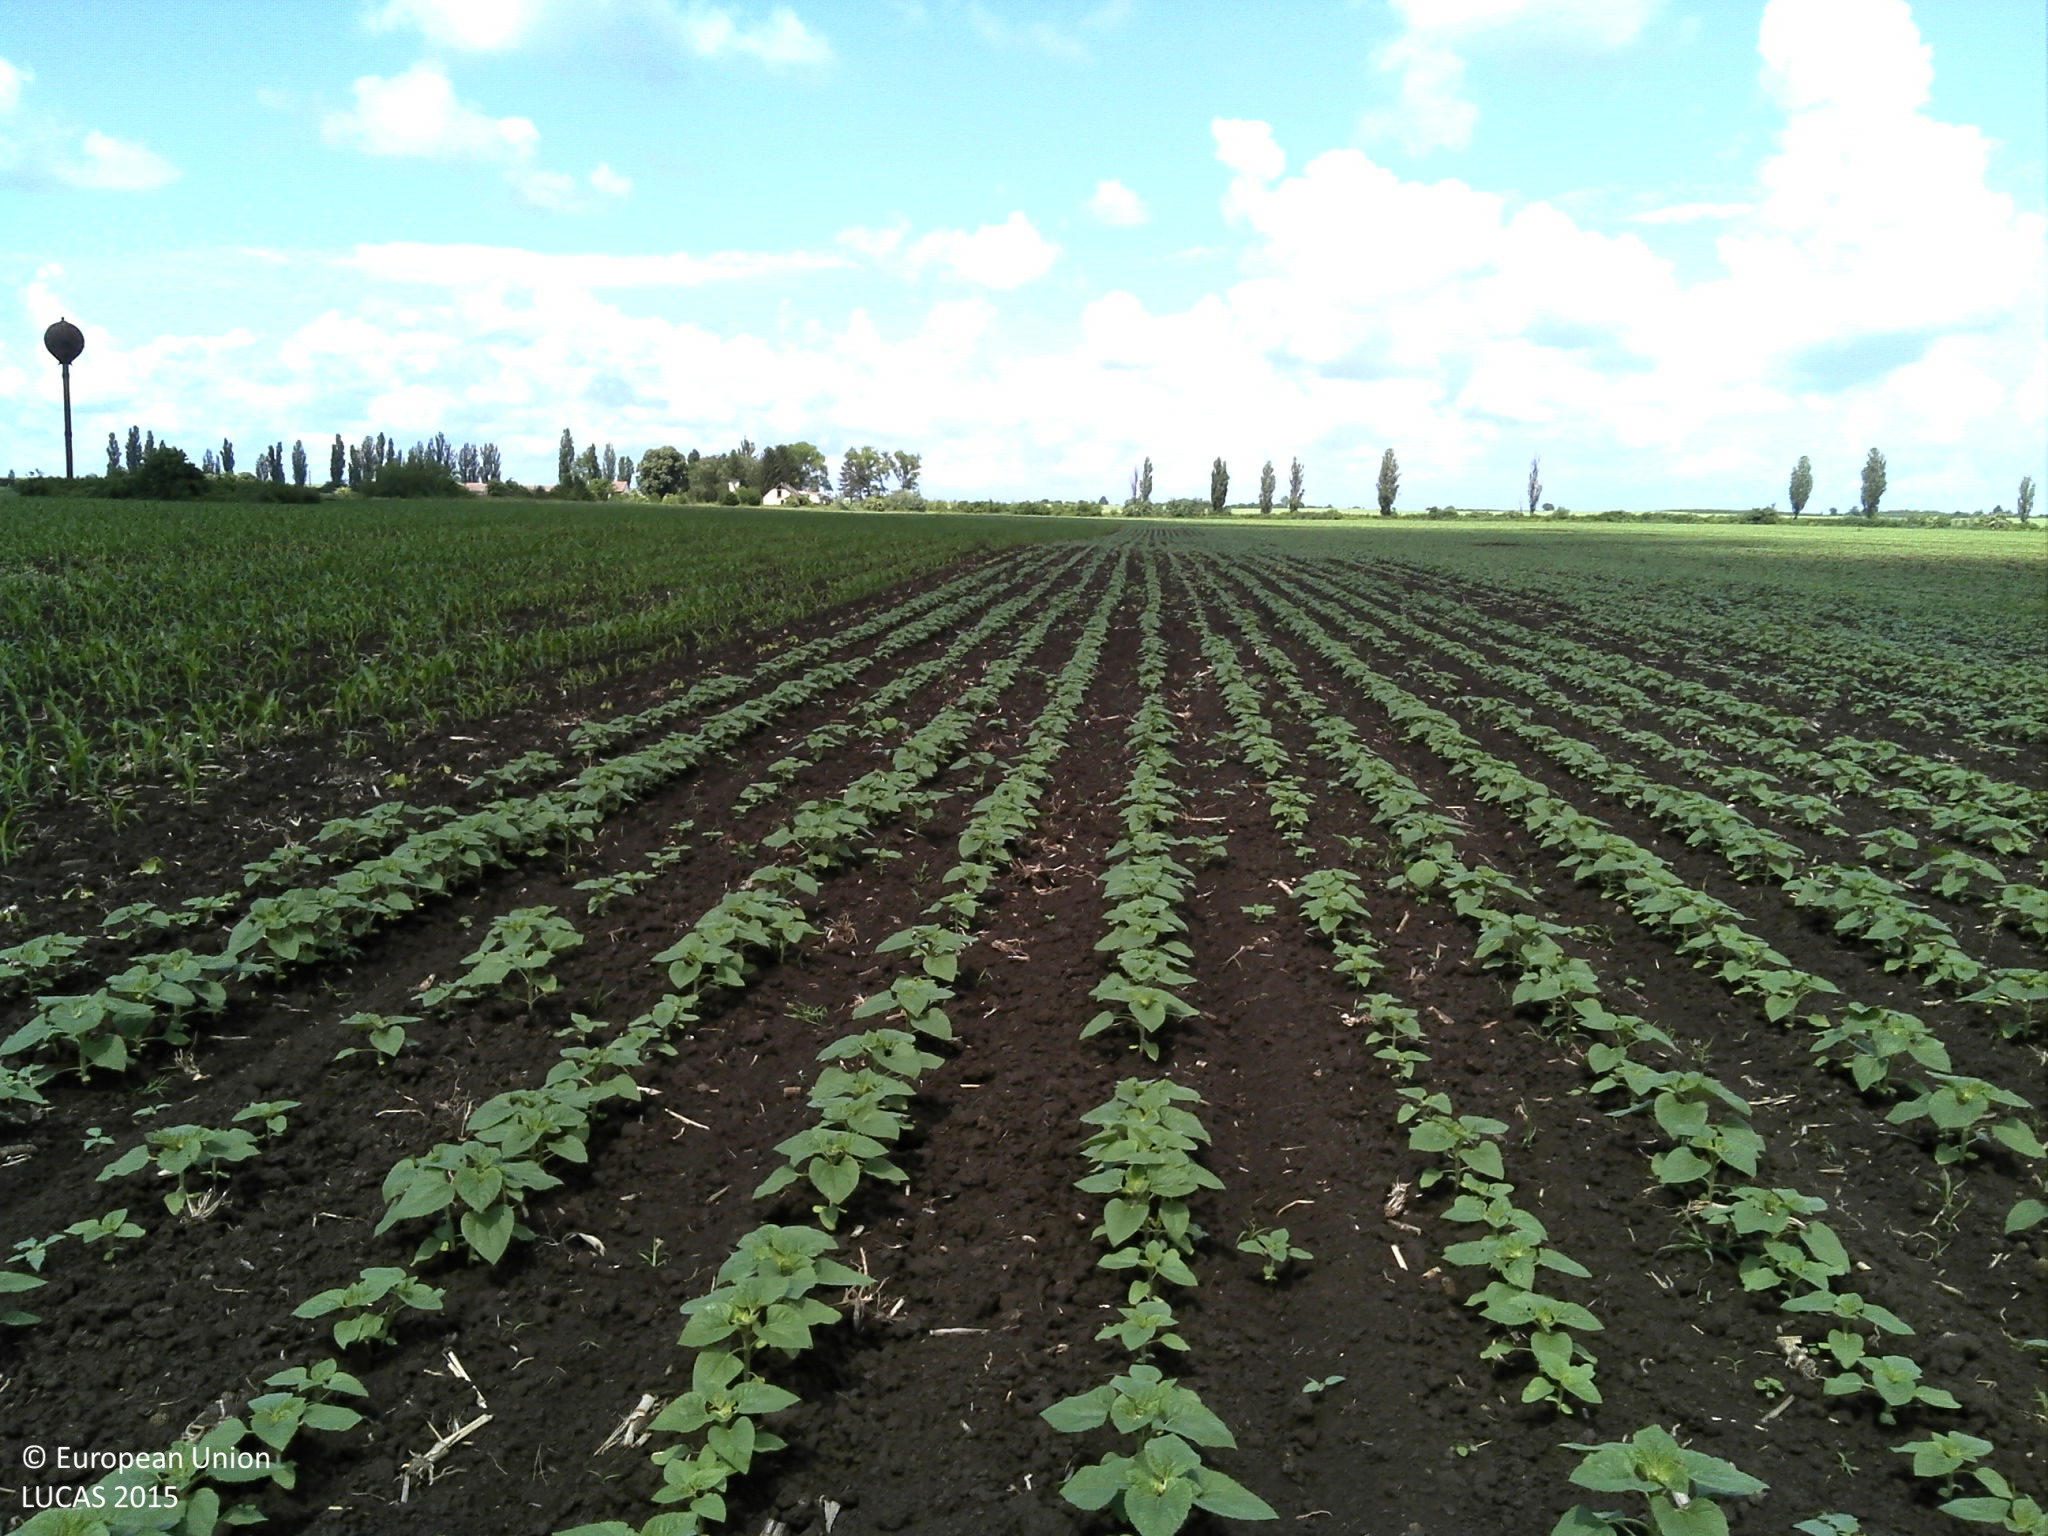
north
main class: Cropland
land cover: Sunflower
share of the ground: 10 - 25 %
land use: Agriculture (excluding fallow land and kitchen gardens)
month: May
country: HR
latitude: 45.5060
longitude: 18.9299
